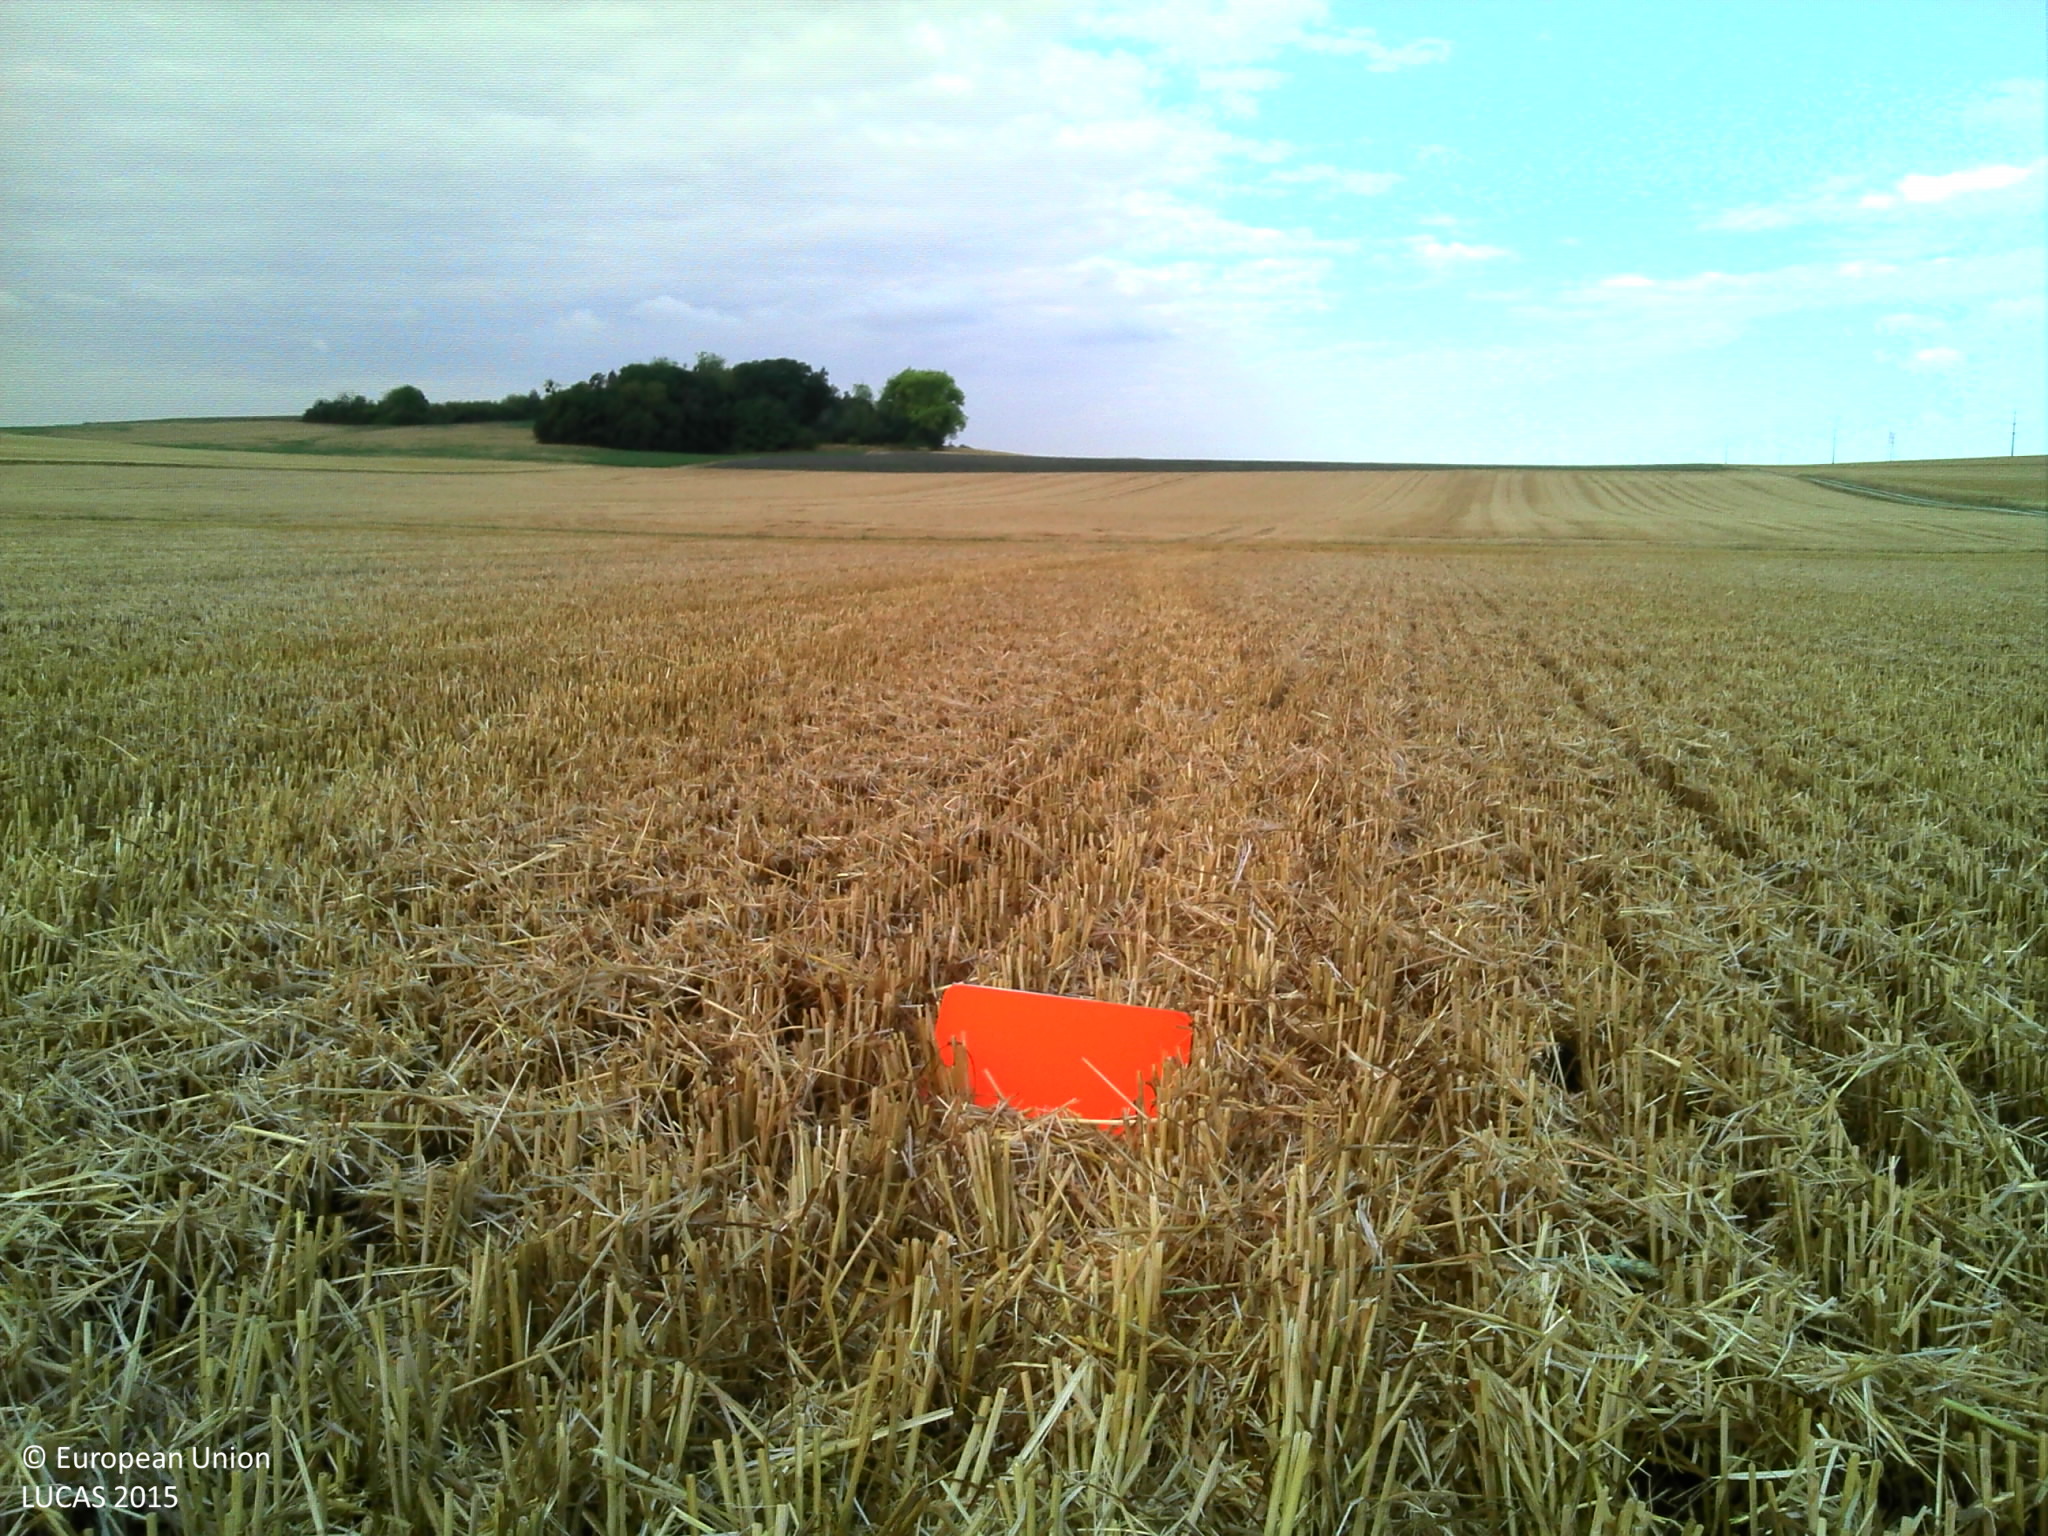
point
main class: Cropland
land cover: Common wheat
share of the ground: > 75 %
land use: Agriculture (excluding fallow land and kitchen gardens)
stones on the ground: < 10 %
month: July
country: FR
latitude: 49.2755
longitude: 4.1262
